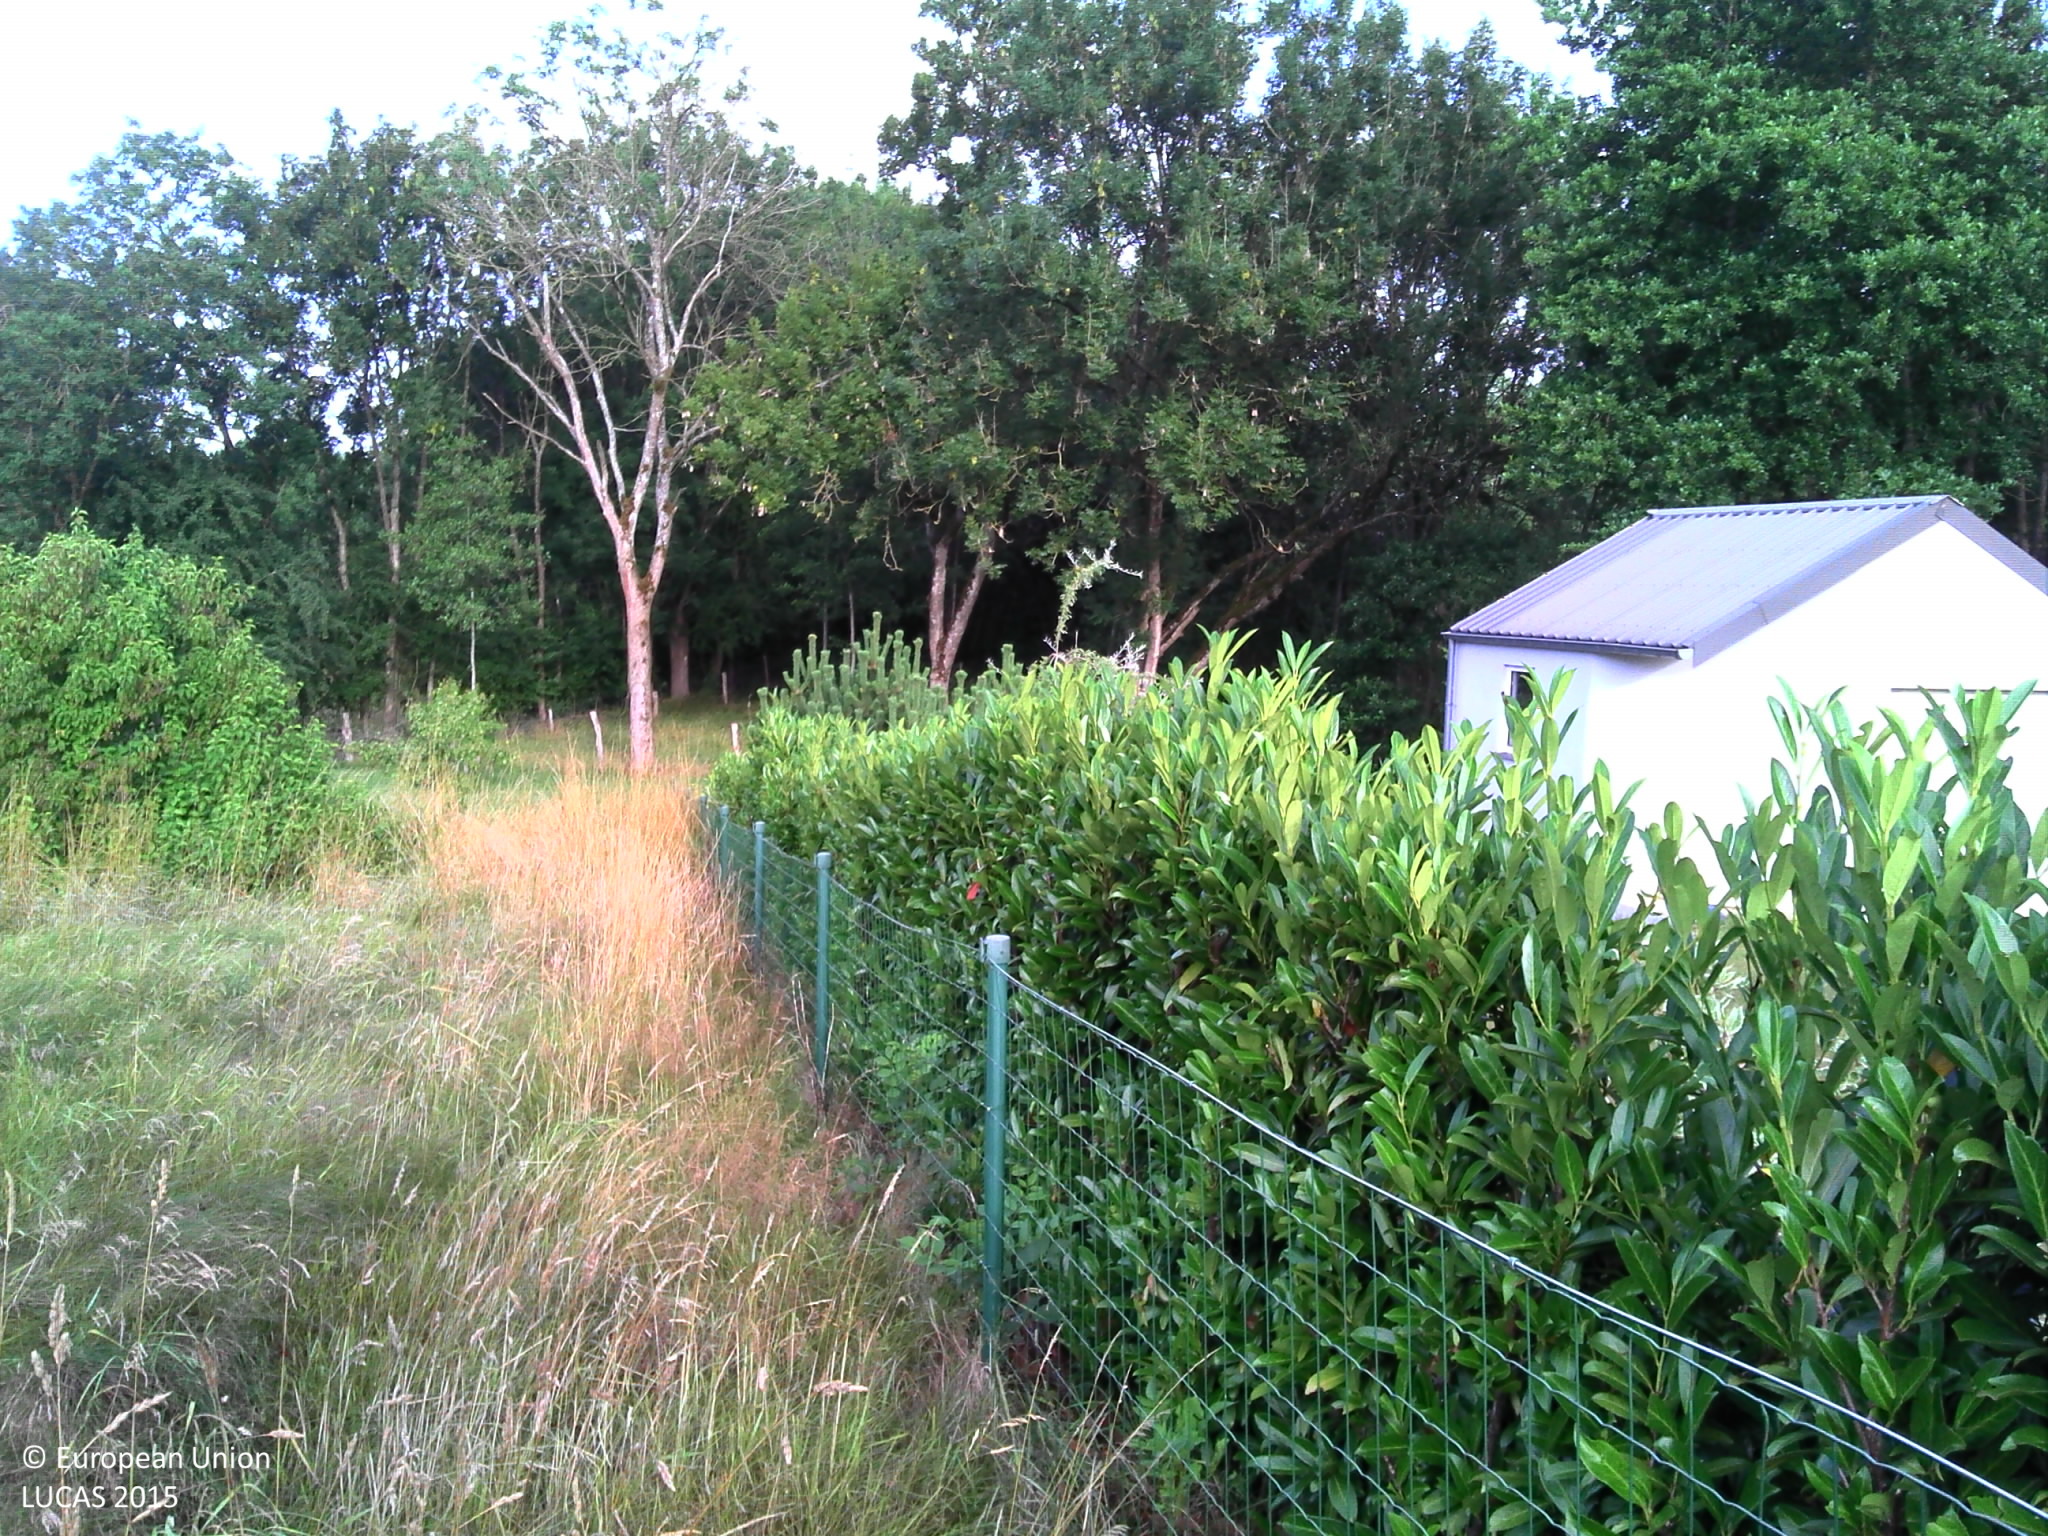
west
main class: Grassland
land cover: Grassland without tree/shrub cover
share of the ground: > 75 %
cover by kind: herbaceous plants 100 %
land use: Residential
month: July
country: BE
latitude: 49.6927
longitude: 5.7985
